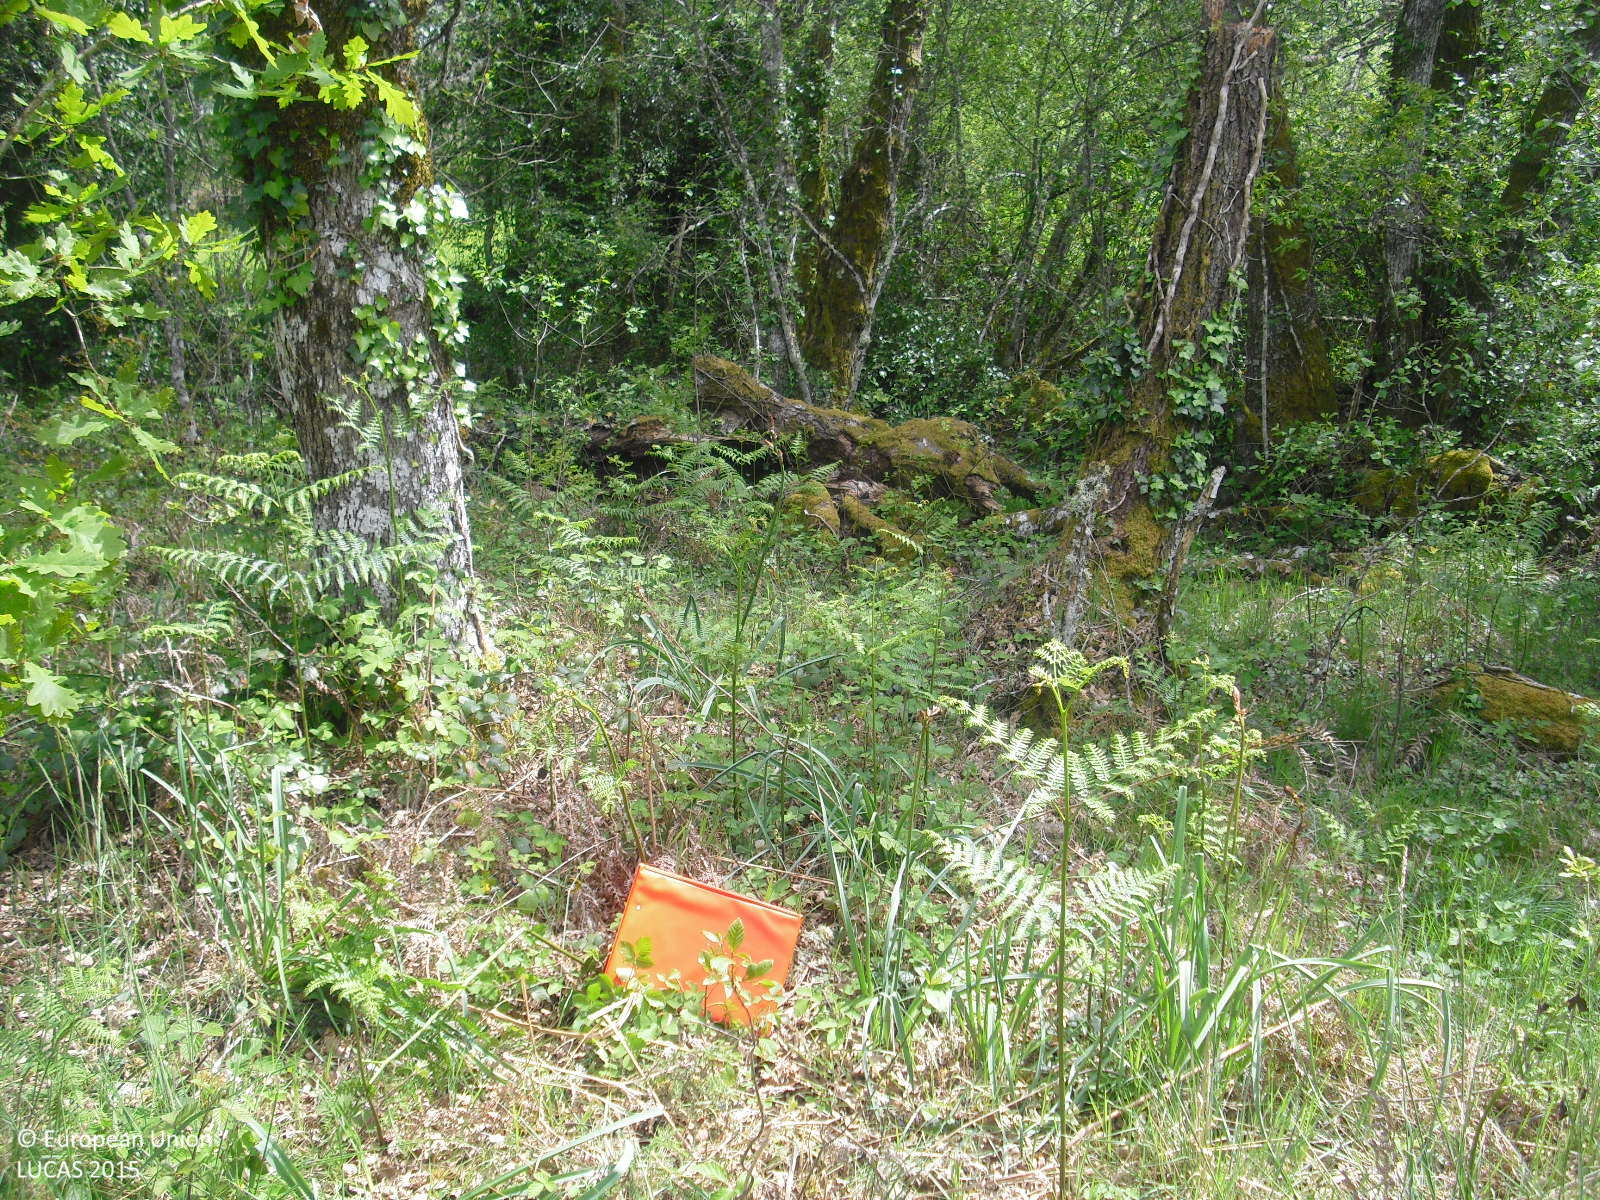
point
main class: Woodland
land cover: Broadleaved woodland
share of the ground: 50 - 75 %
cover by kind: broadleaved forest trees 60 %, herbaceous plants 25 %, shrubs 15 %
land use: Forestry
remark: Clear cut
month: May
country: ES
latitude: 42.1288
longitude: -7.8196
